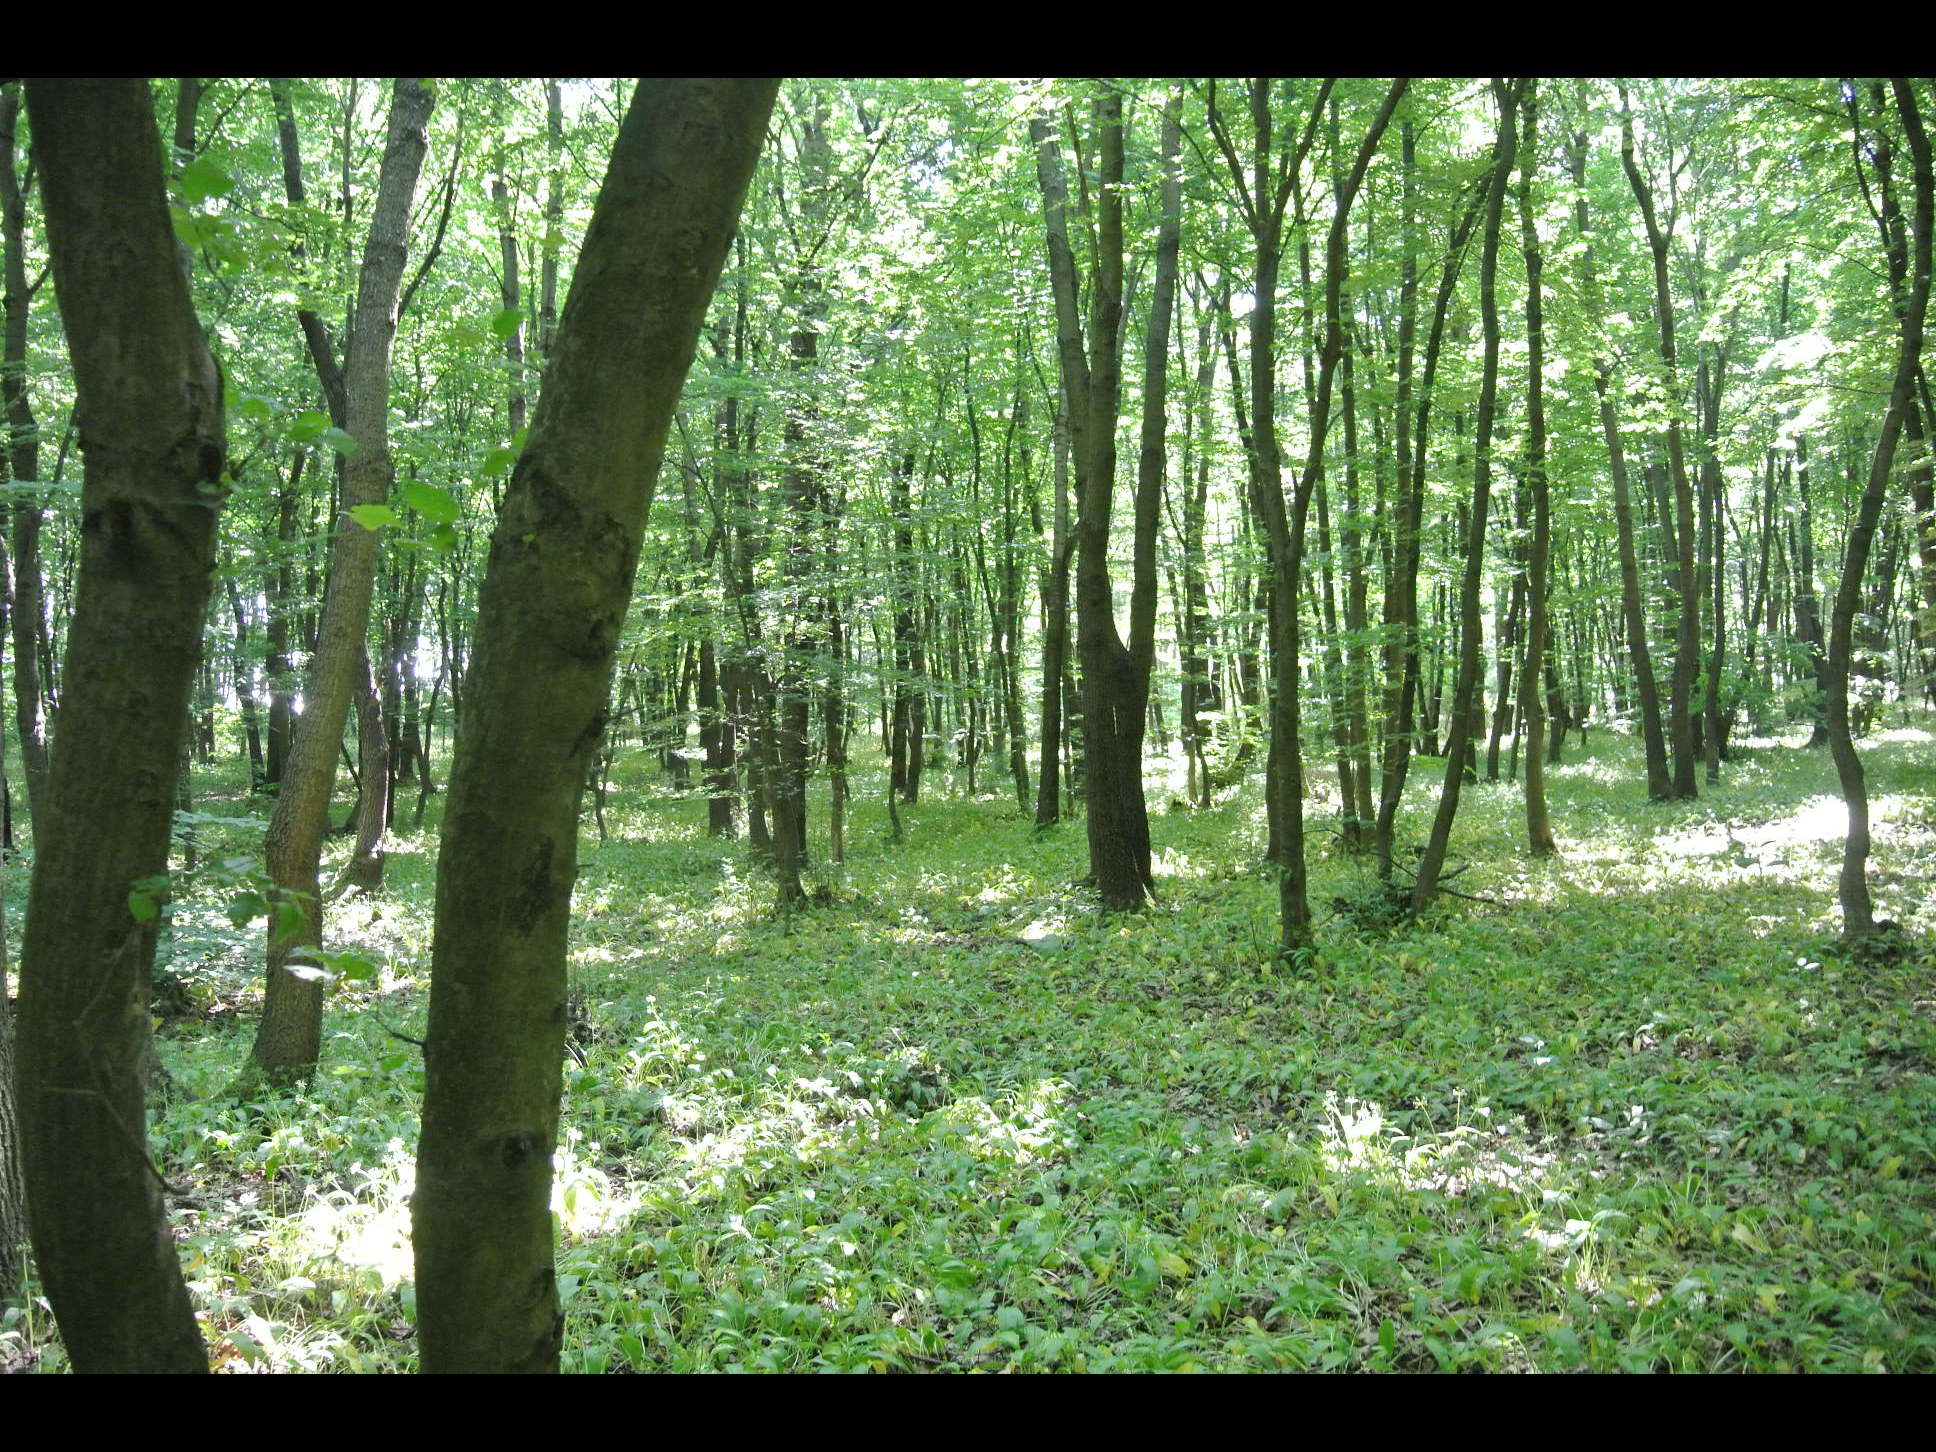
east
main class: Woodland
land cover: Broadleaved woodland
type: mesophytic deciduous forest
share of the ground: > 75 %
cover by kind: broadleaved forest trees 100 %
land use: Forestry
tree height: > 5 m
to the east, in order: Broadleaved woodland; Tracks; Grass margins; Sugar beet
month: June
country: AT
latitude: 47.9057
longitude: 16.4932
